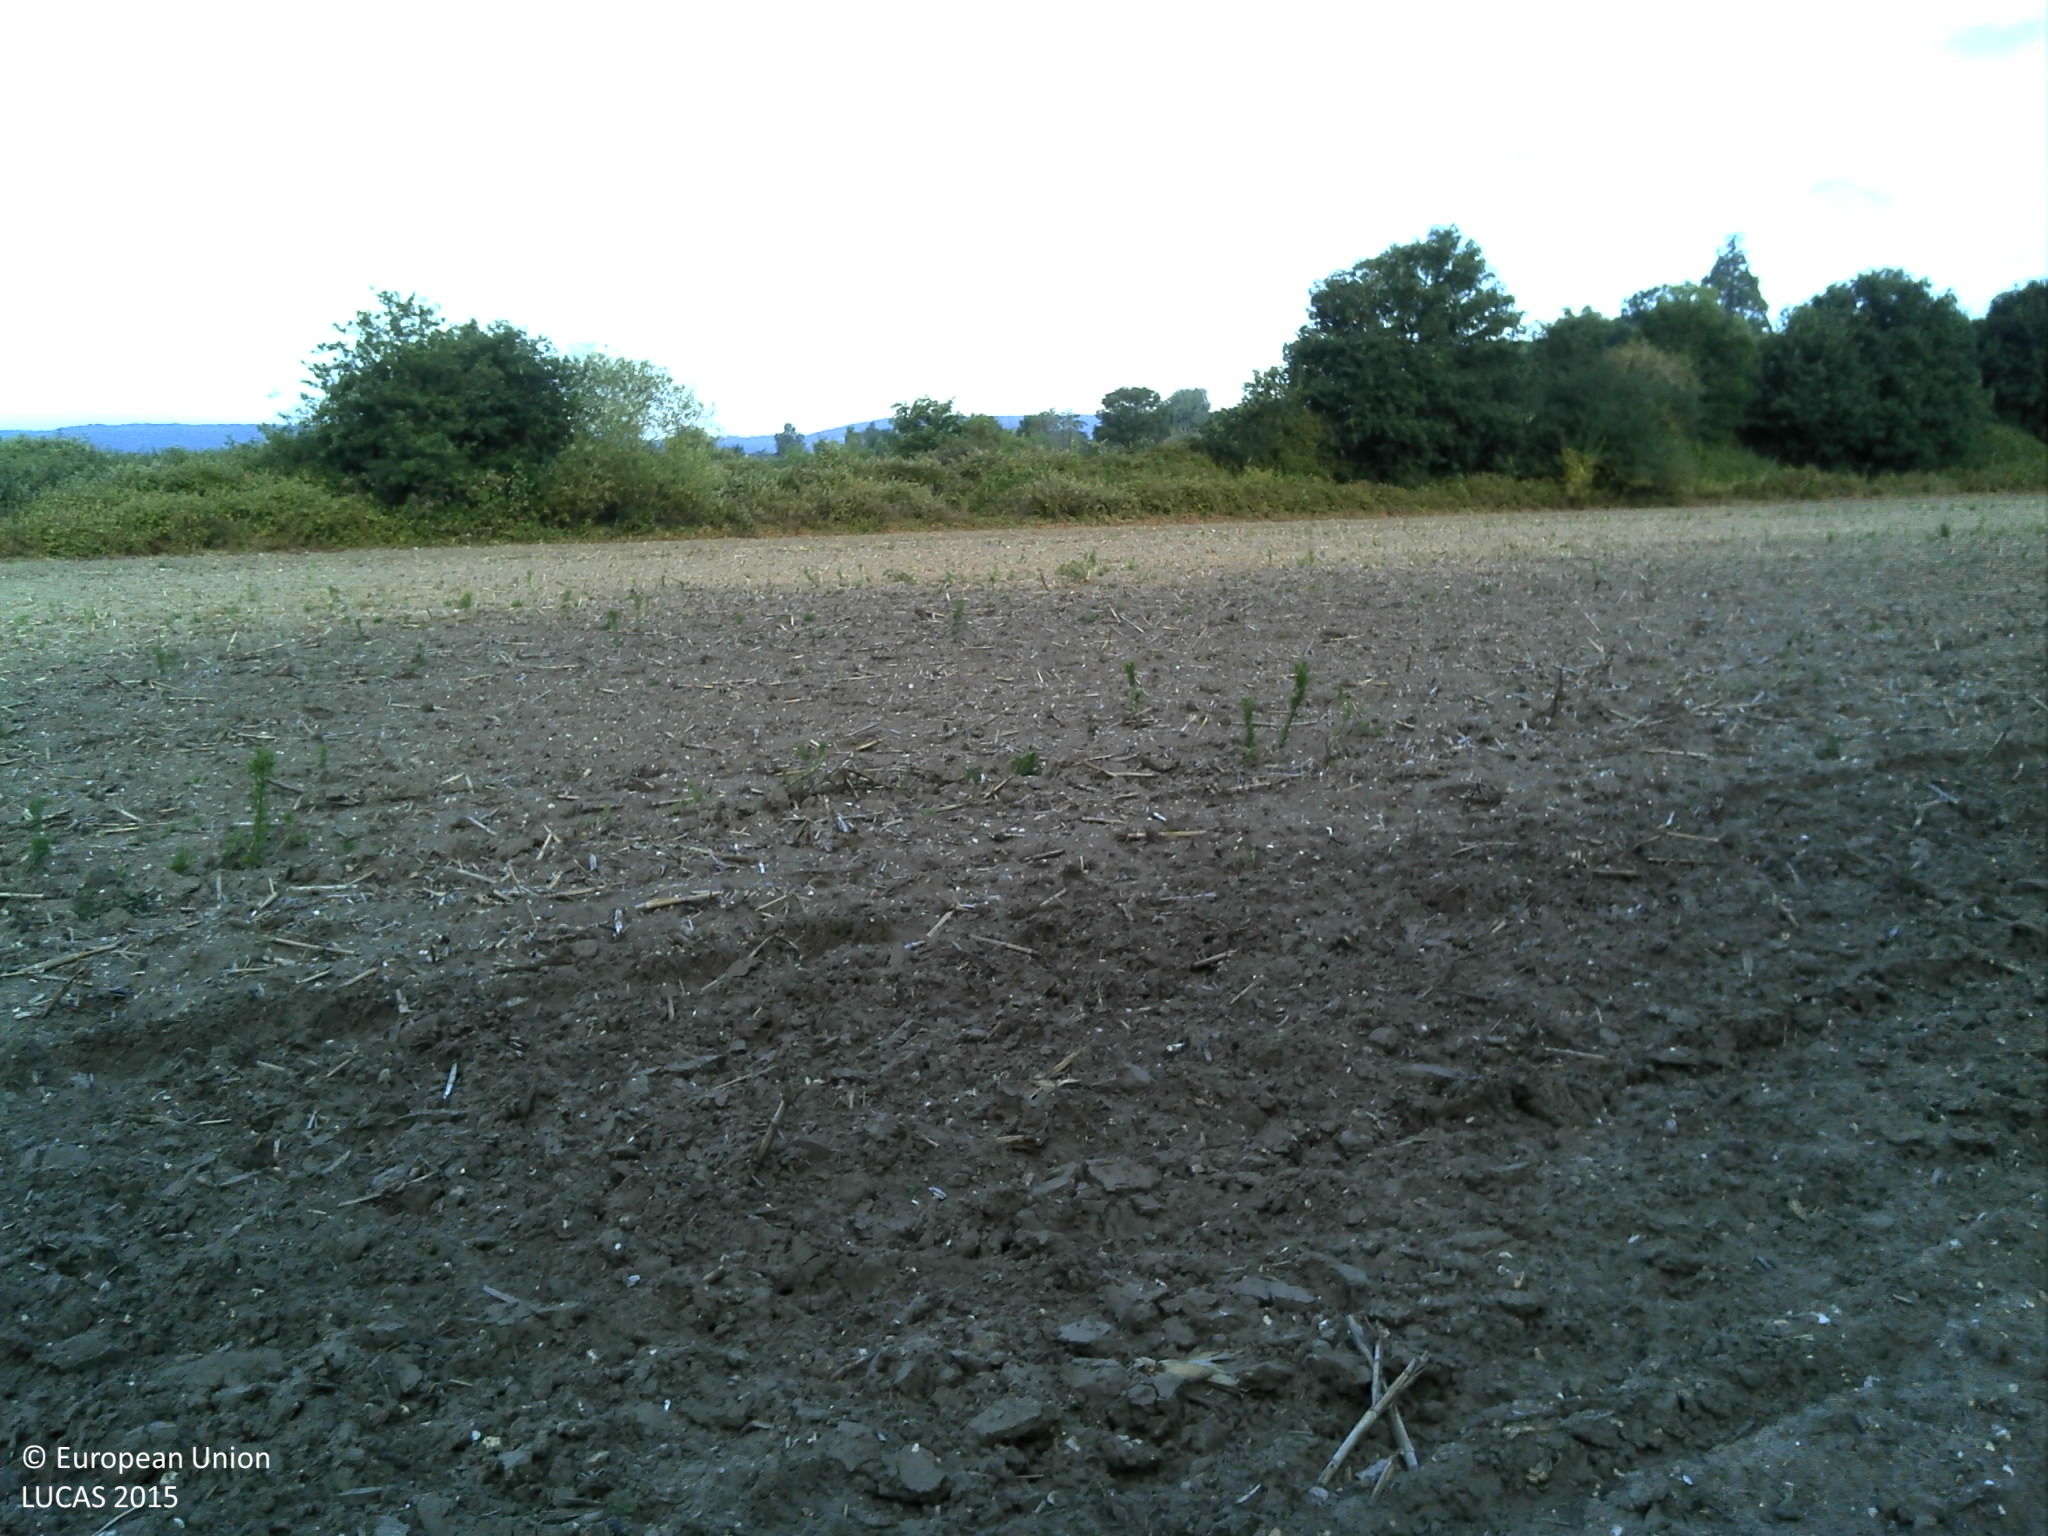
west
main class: Woodland
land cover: Broadleaved woodland
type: acidophilous oak and oak-birch forest
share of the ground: > 75 %
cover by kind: broadleaved forest trees 100 %
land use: Forestry
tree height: > 5 m
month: June
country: FR
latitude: 49.2893
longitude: 1.0554
